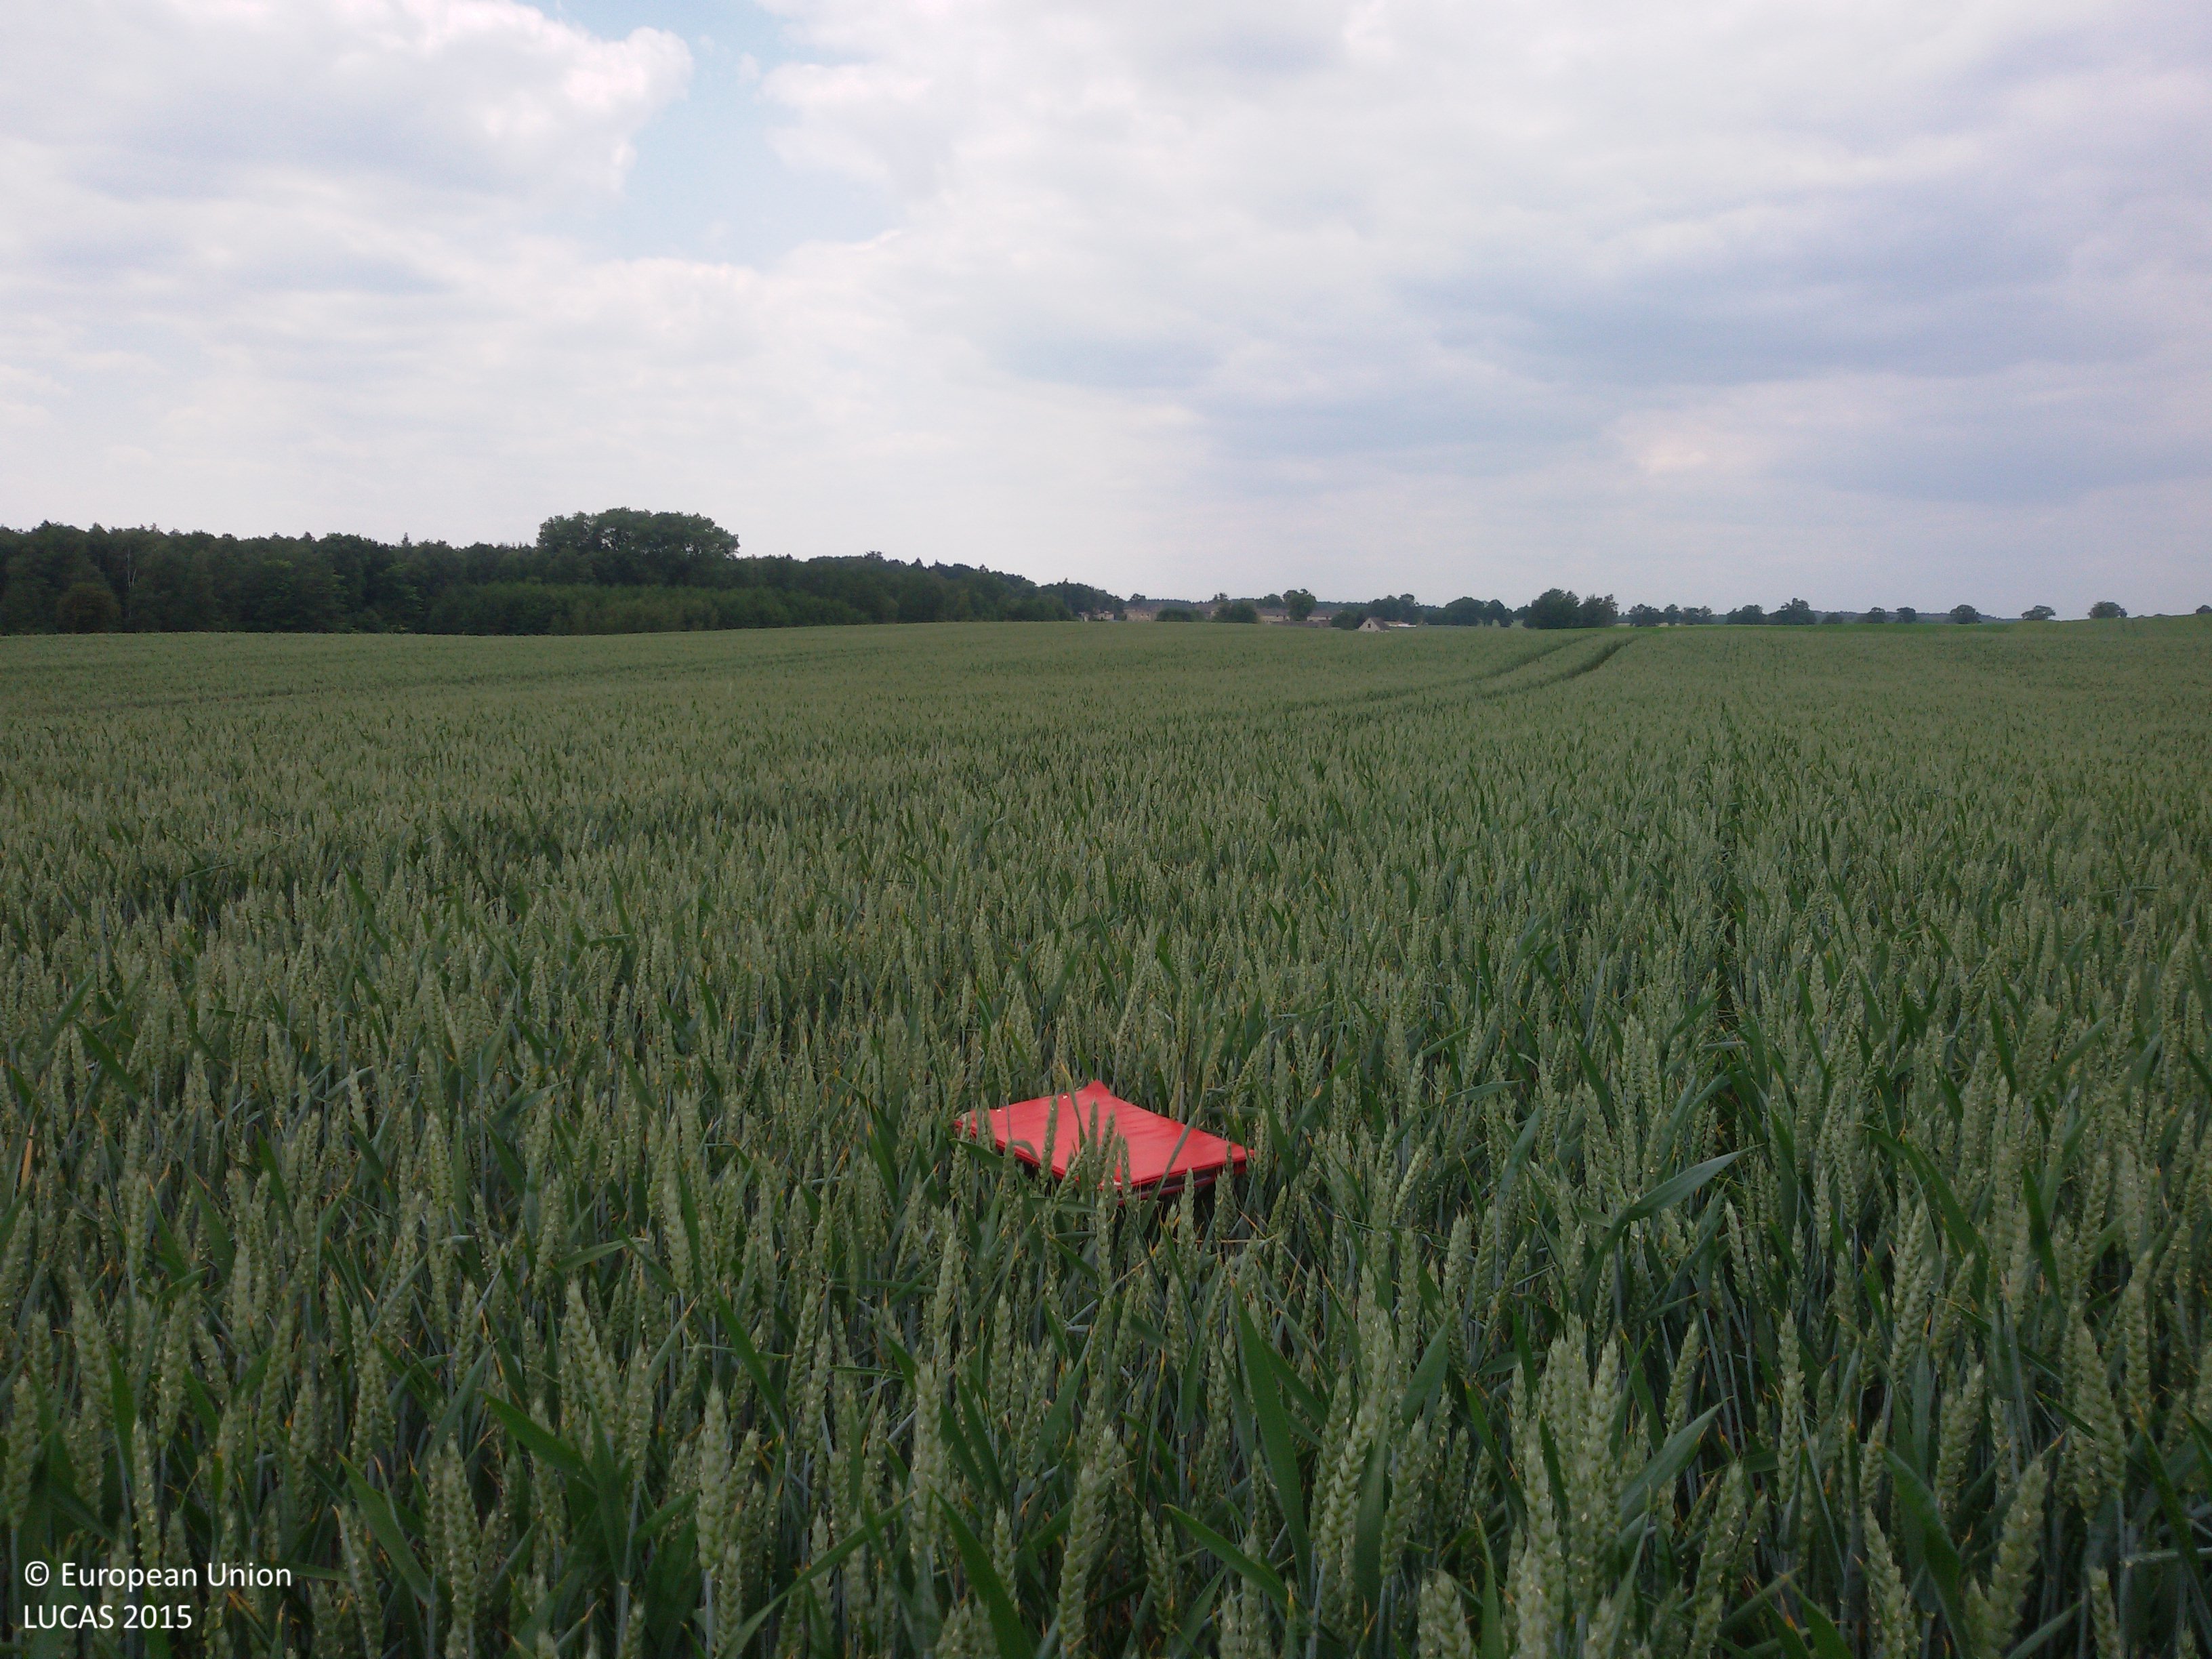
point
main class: Cropland
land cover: Common wheat
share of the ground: > 75 %
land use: Agriculture (excluding fallow land and kitchen gardens)
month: June
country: PL
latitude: 53.4292
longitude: 17.6734
